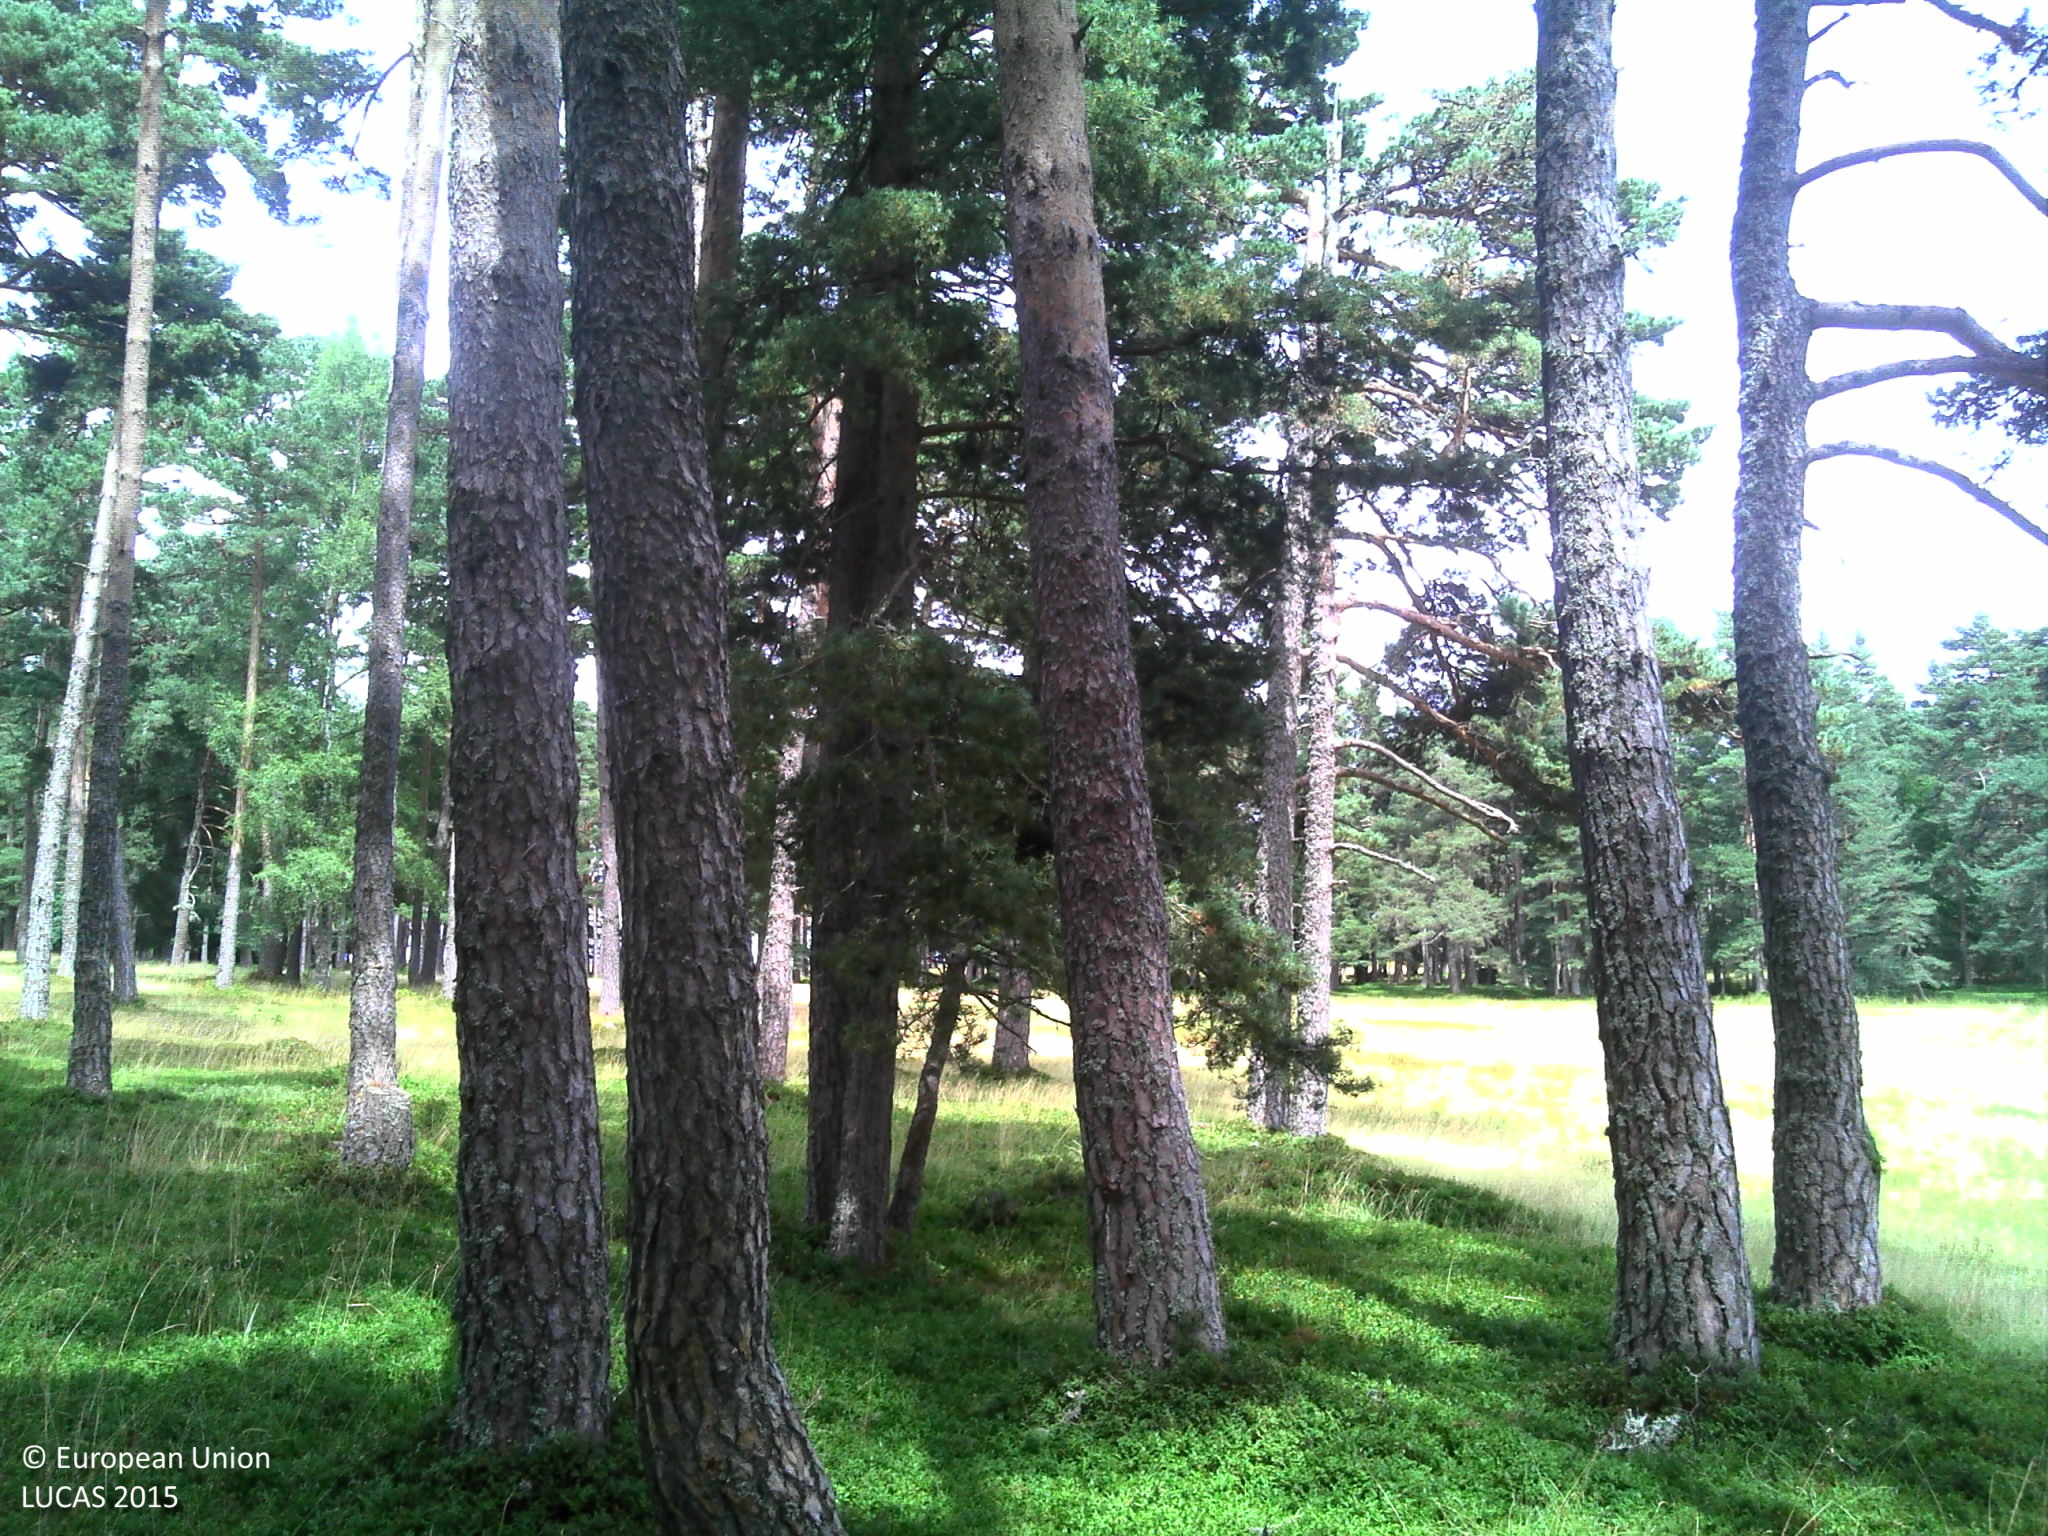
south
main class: Woodland
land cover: Pine dominated coniferous woodland
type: hemiboreal forest and nemoral coniferous forest and mixed broadleaved-coniferous forest
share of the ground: > 75 %
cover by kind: coniferous forest trees 95 %, broadleaved forest trees 5 %
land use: Forestry
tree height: > 5 m
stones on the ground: 10 - 25 %
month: July
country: FR
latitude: 44.8483
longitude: 3.1581
